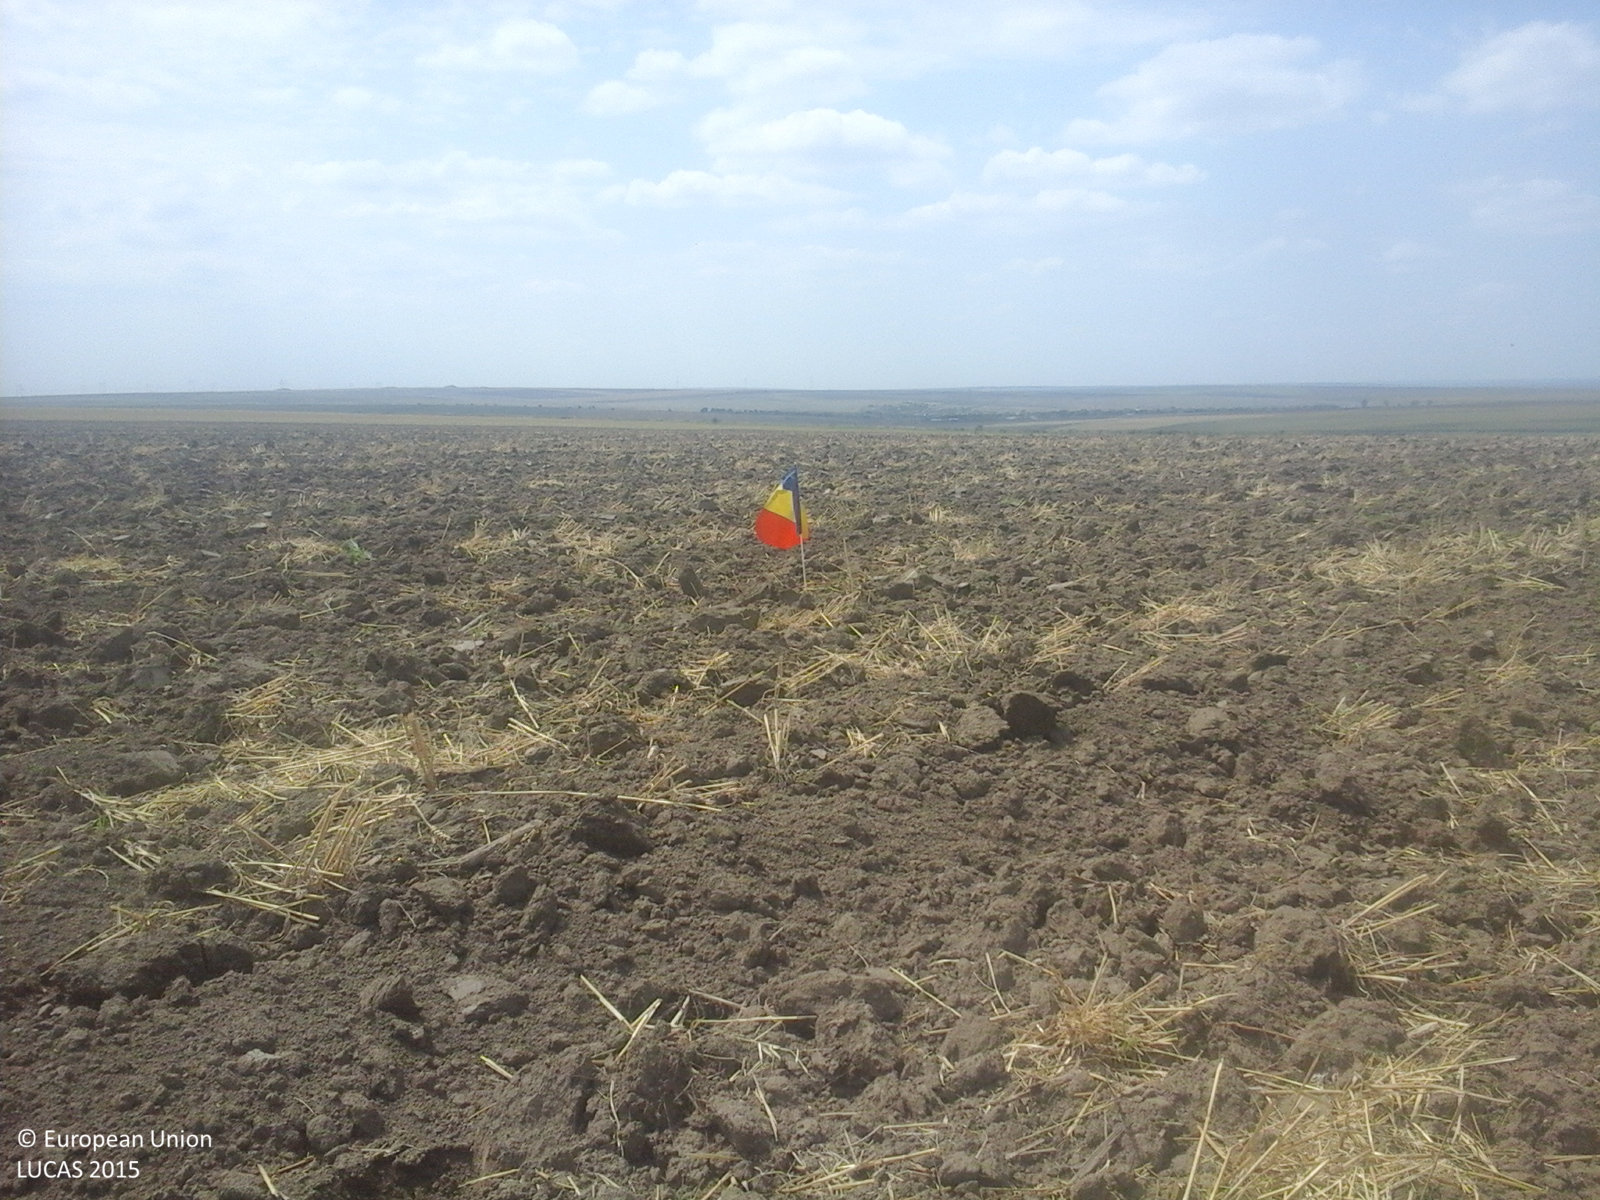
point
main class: Cropland
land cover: Common wheat
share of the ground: < 10 %
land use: Agriculture (excluding fallow land and kitchen gardens)
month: August
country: RO
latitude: 44.7030
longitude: 28.2799
